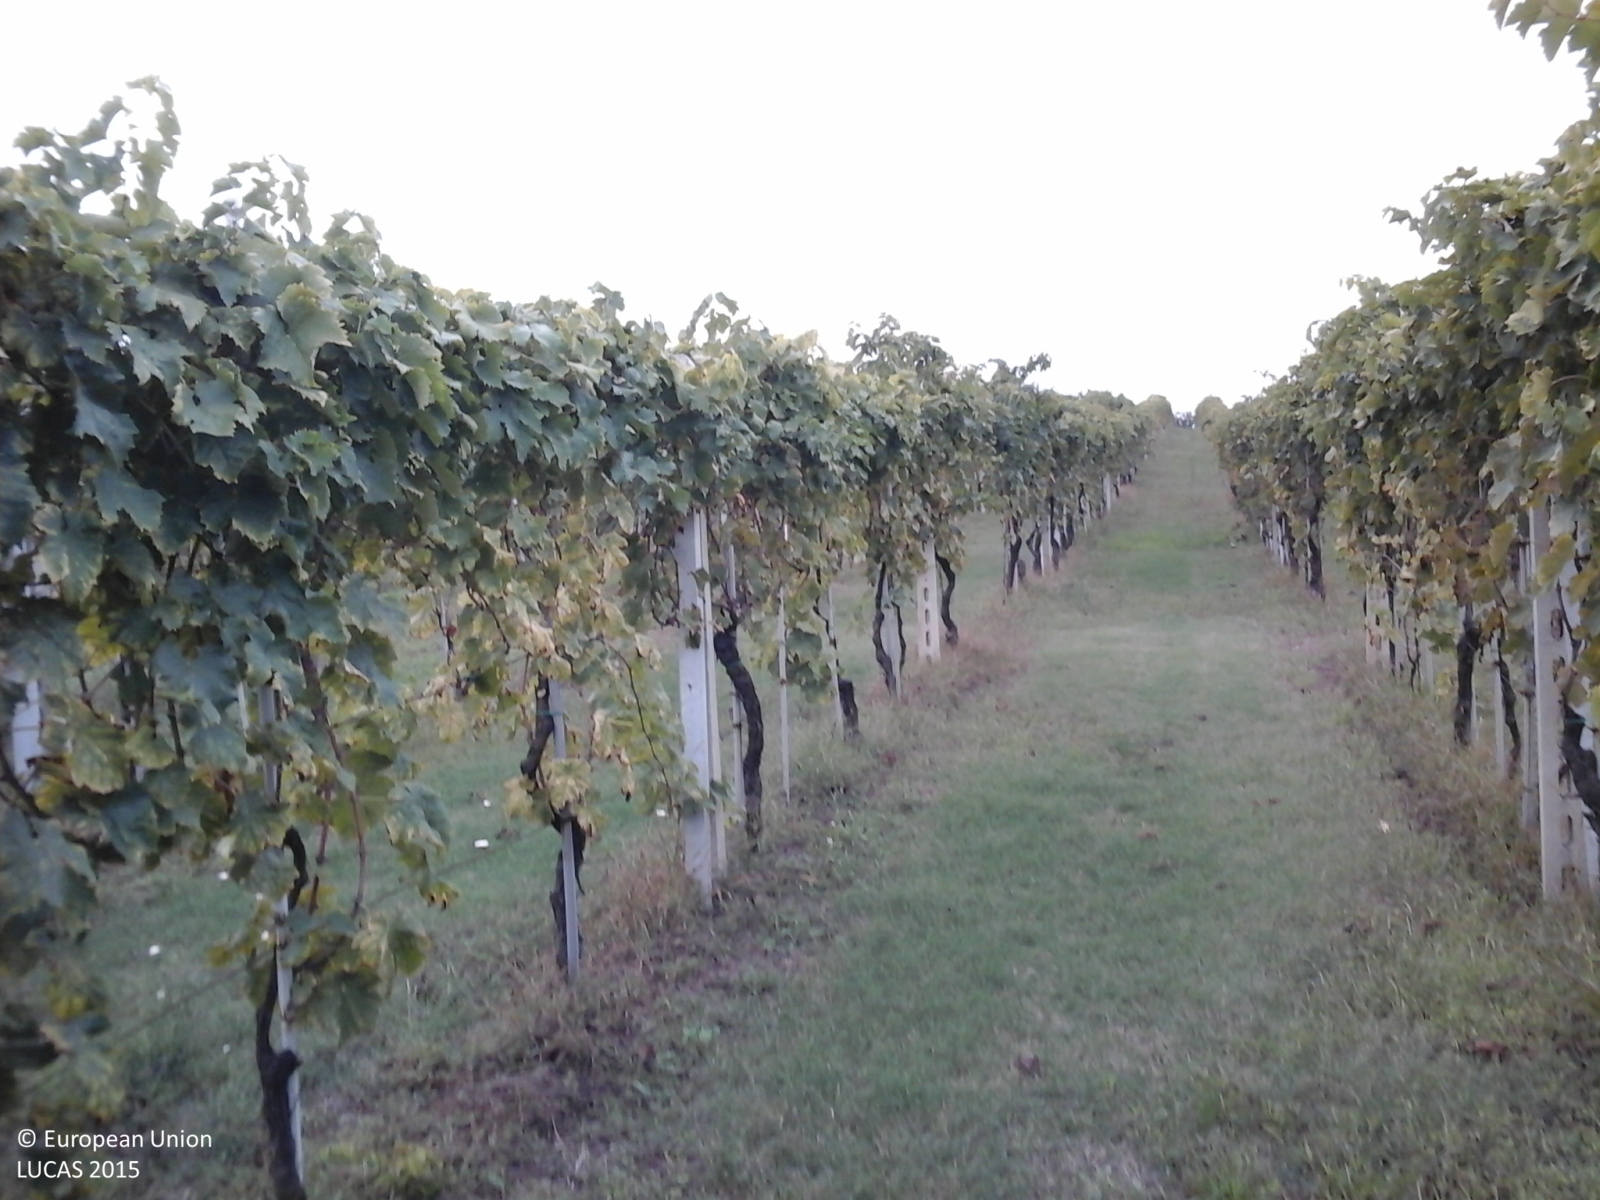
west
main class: Cropland
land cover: Vineyards
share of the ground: 50 - 75 %
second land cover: Grassland without tree/shrub cover
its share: > 75 %
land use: Agriculture (excluding fallow land and kitchen gardens)
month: October
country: IT
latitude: 43.5153
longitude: 13.4924
